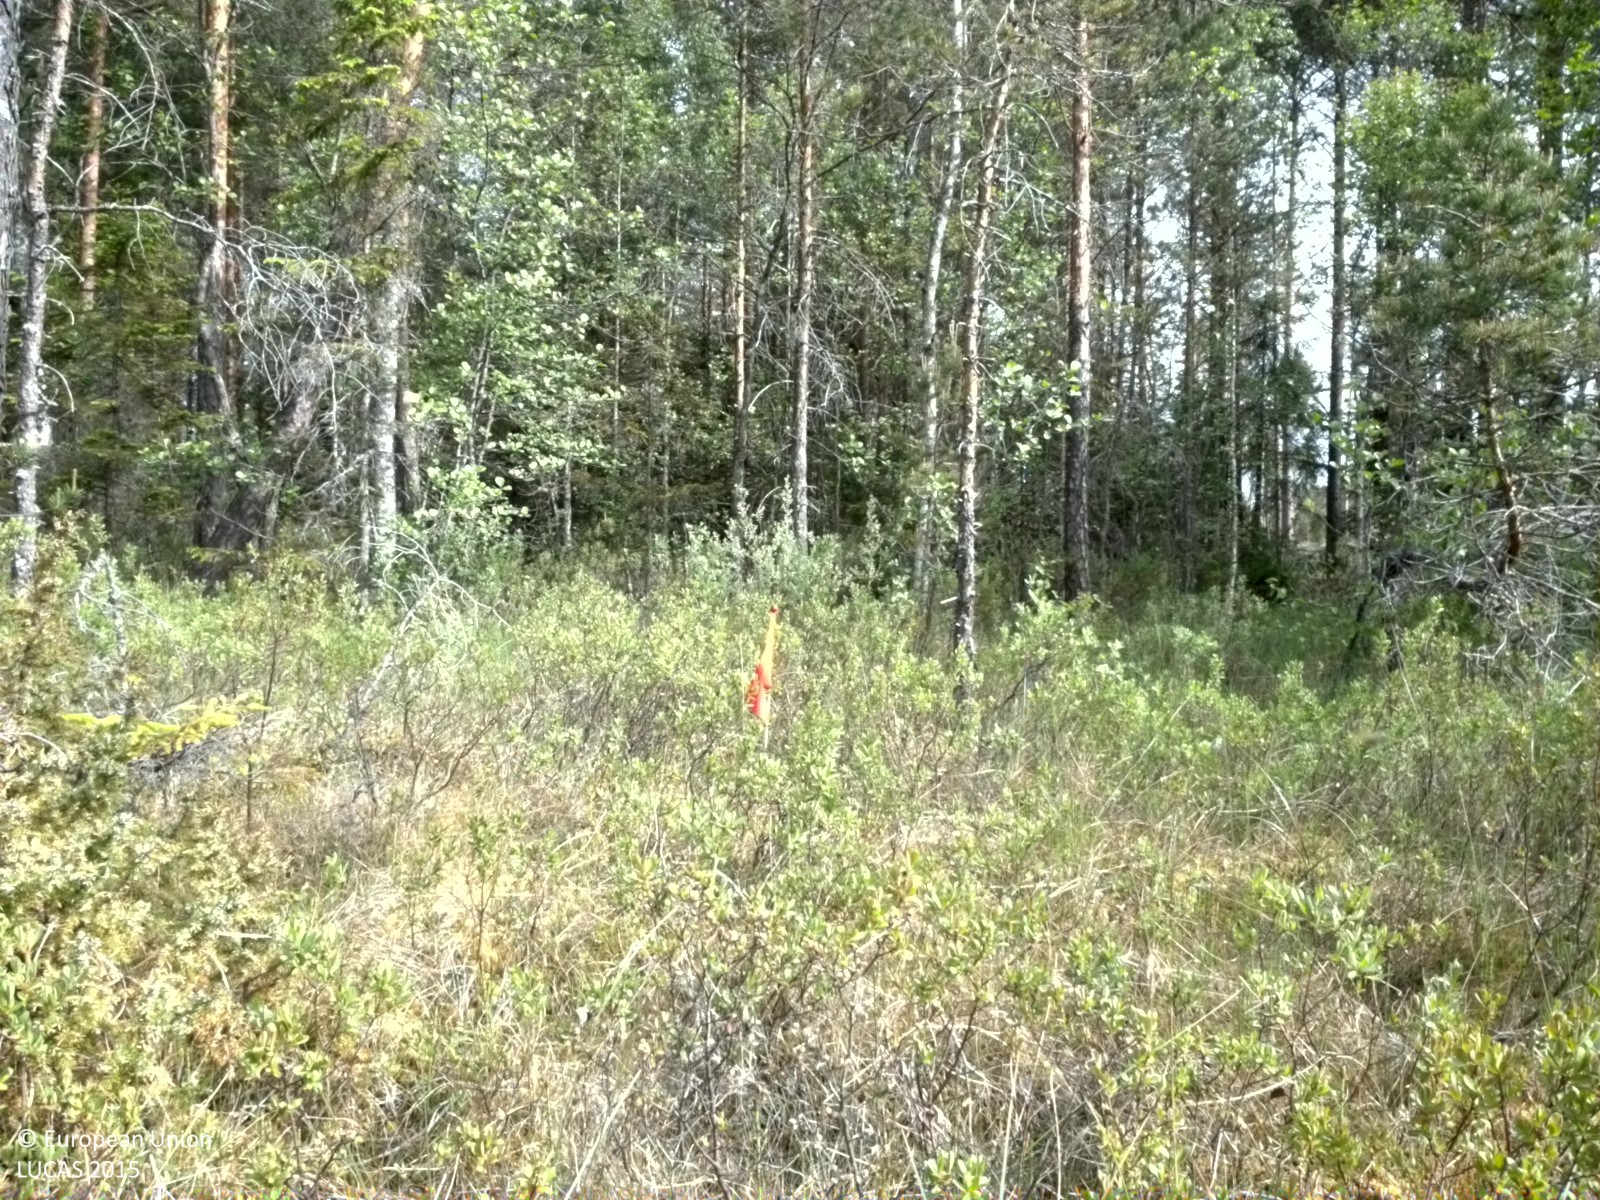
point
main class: Woodland
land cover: Pine dominated coniferous woodland
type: mire and swamp forests
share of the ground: 25 - 50 %
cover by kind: coniferous forest trees 40 %, shrubs 25 %, herbaceous plants 15 %, lichens and mosses 15 %, broadleaved forest trees 5 %
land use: Semi-natural and natural areas not in use
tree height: > 5 m
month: June
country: SE
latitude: 60.2481
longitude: 17.2355
